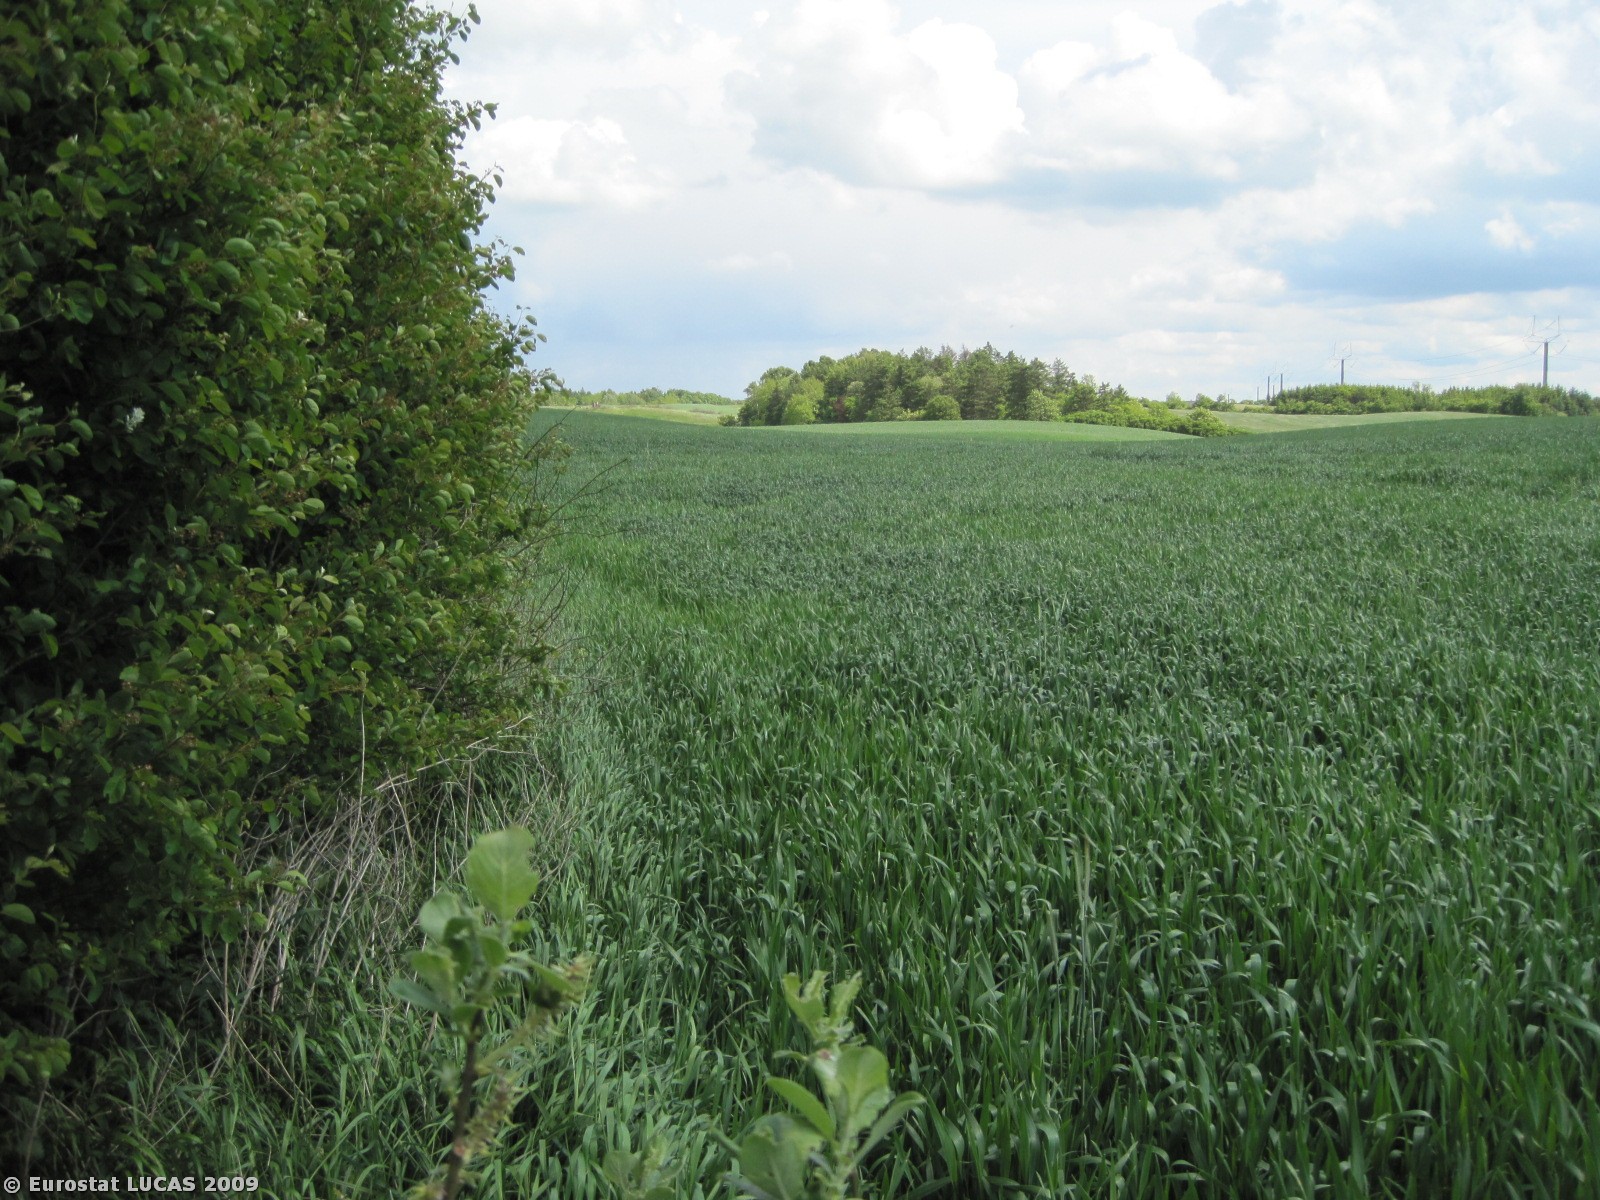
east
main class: Woodland
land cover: Broadleaved woodland
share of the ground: > 75 %
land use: Unused
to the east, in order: Broadleaved woodland; Common wheat
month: May
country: DK
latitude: 56.7089
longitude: 9.7879
